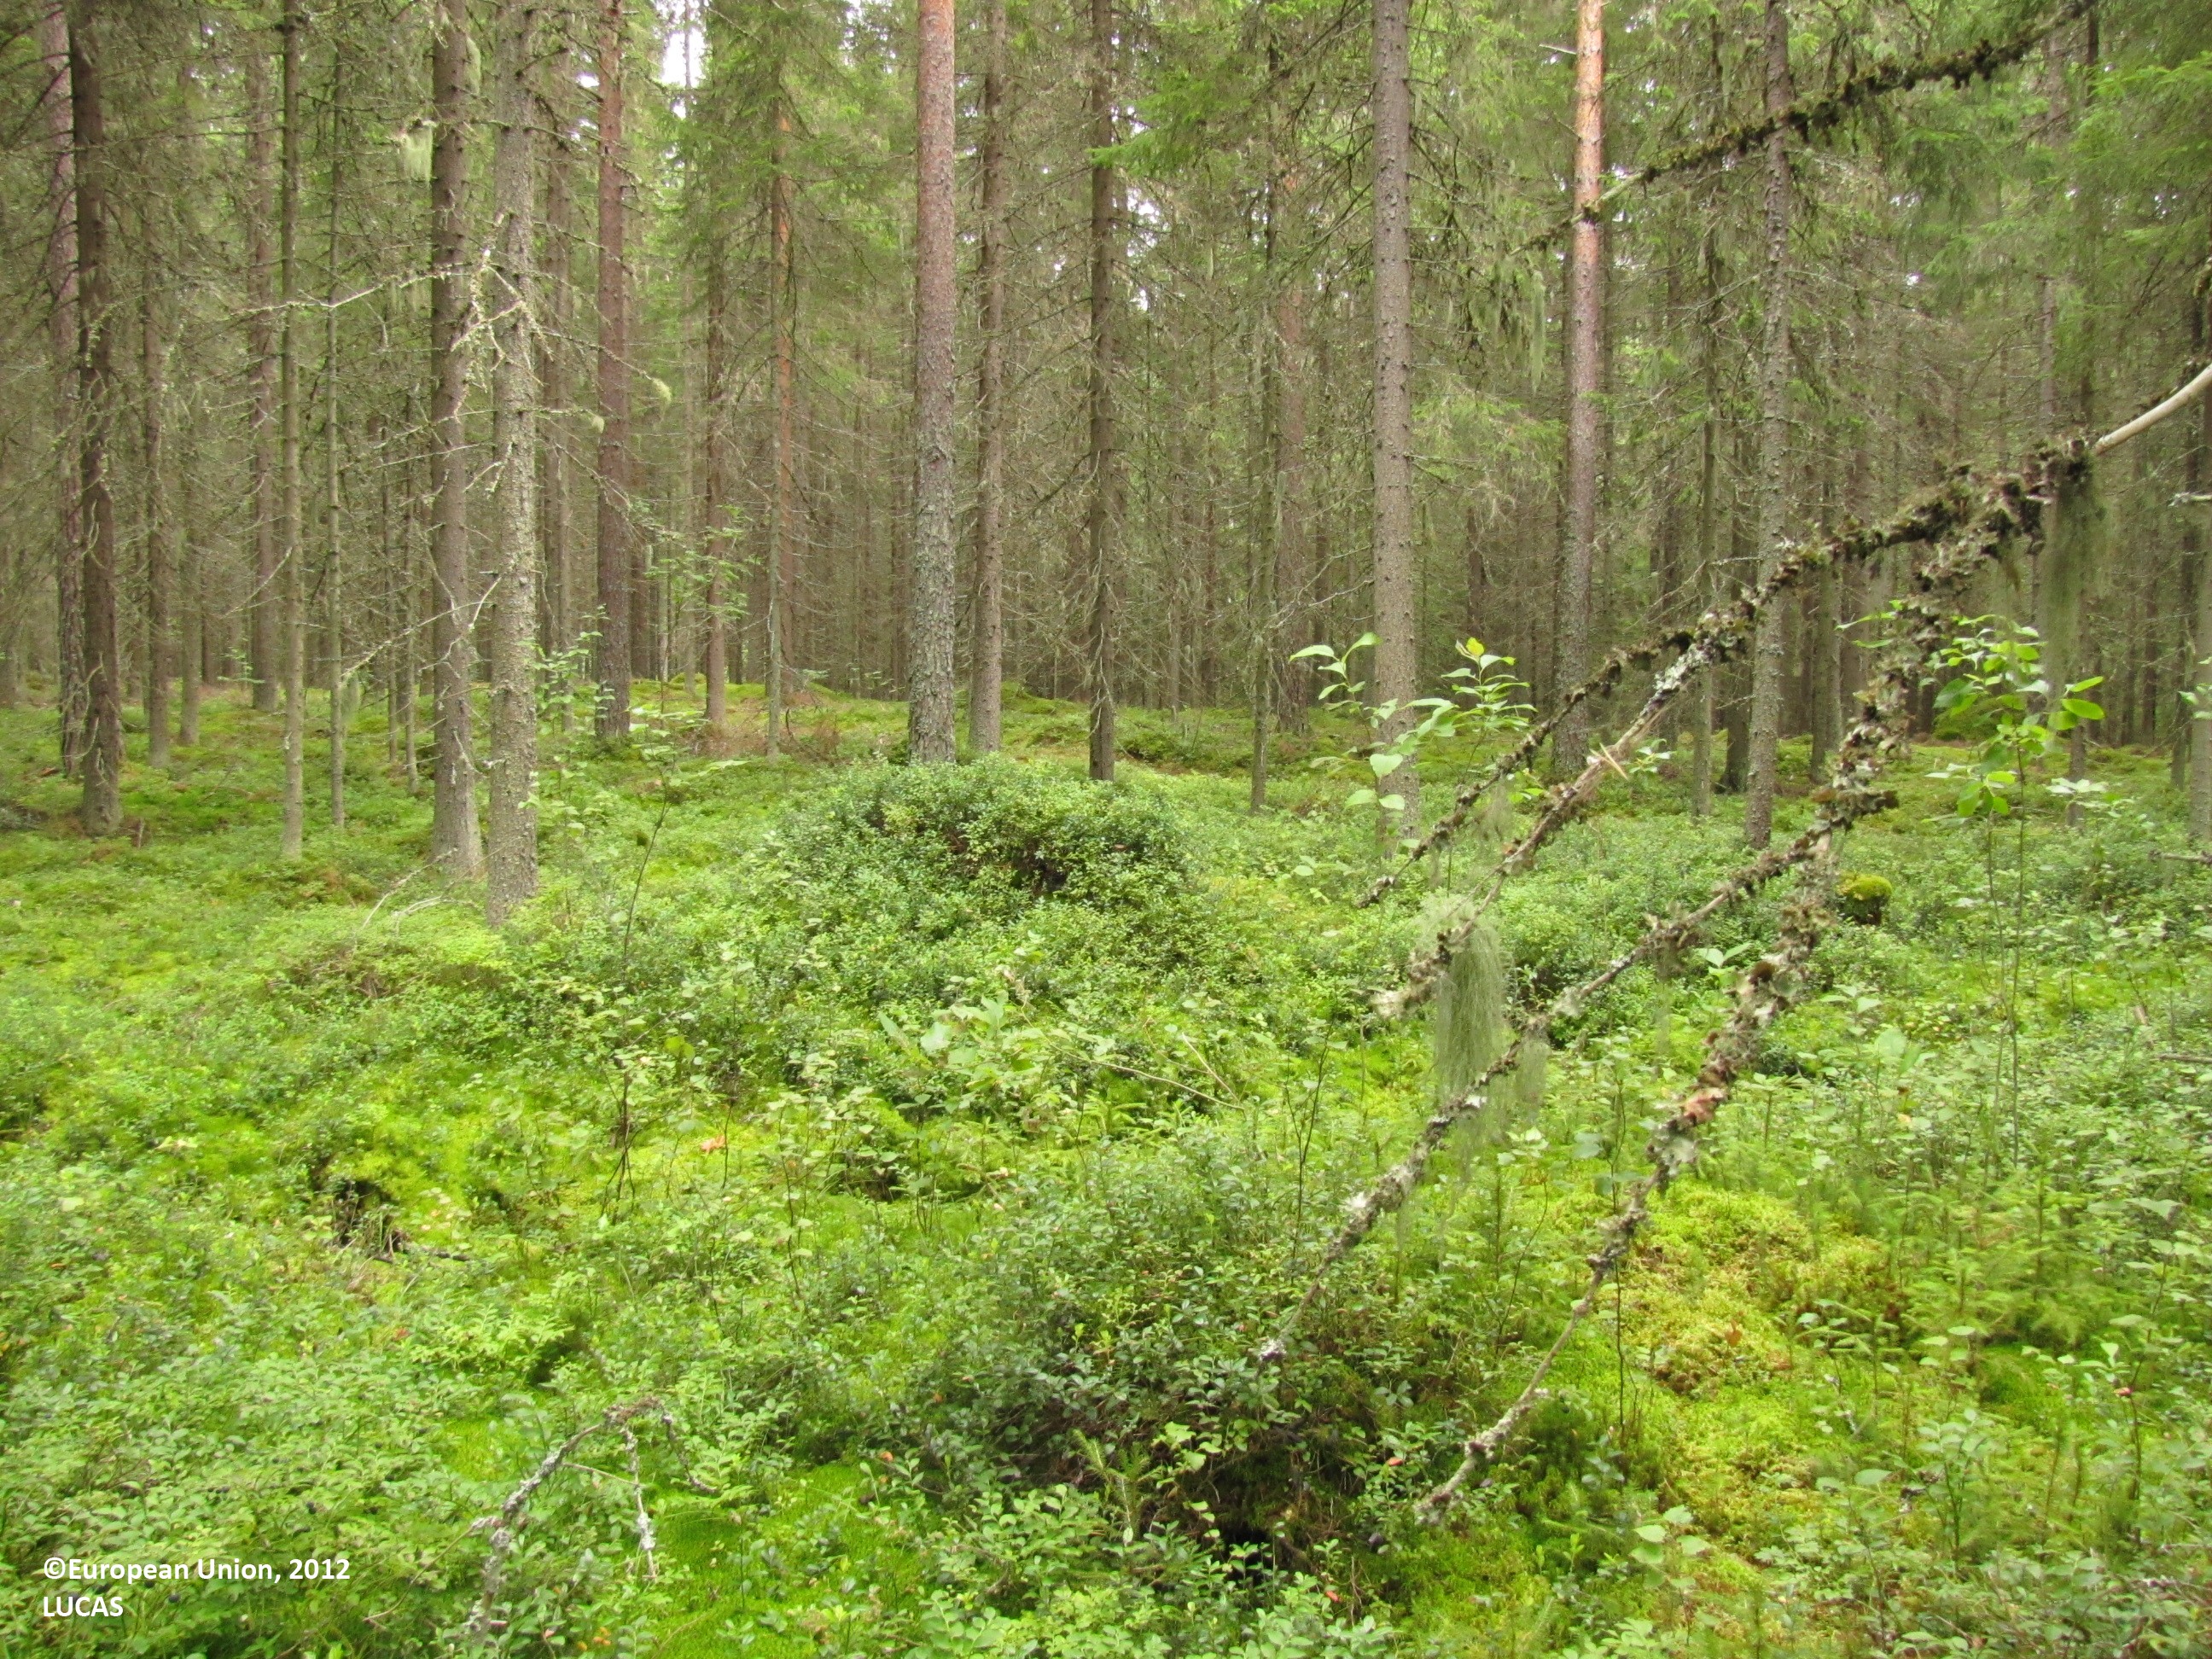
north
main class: Woodland
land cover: Spruce dominated coniferous woodland
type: boreal forest
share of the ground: > 75 %
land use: Forestry
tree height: > 5 m
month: August
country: FI
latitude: 61.8361
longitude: 22.8862
